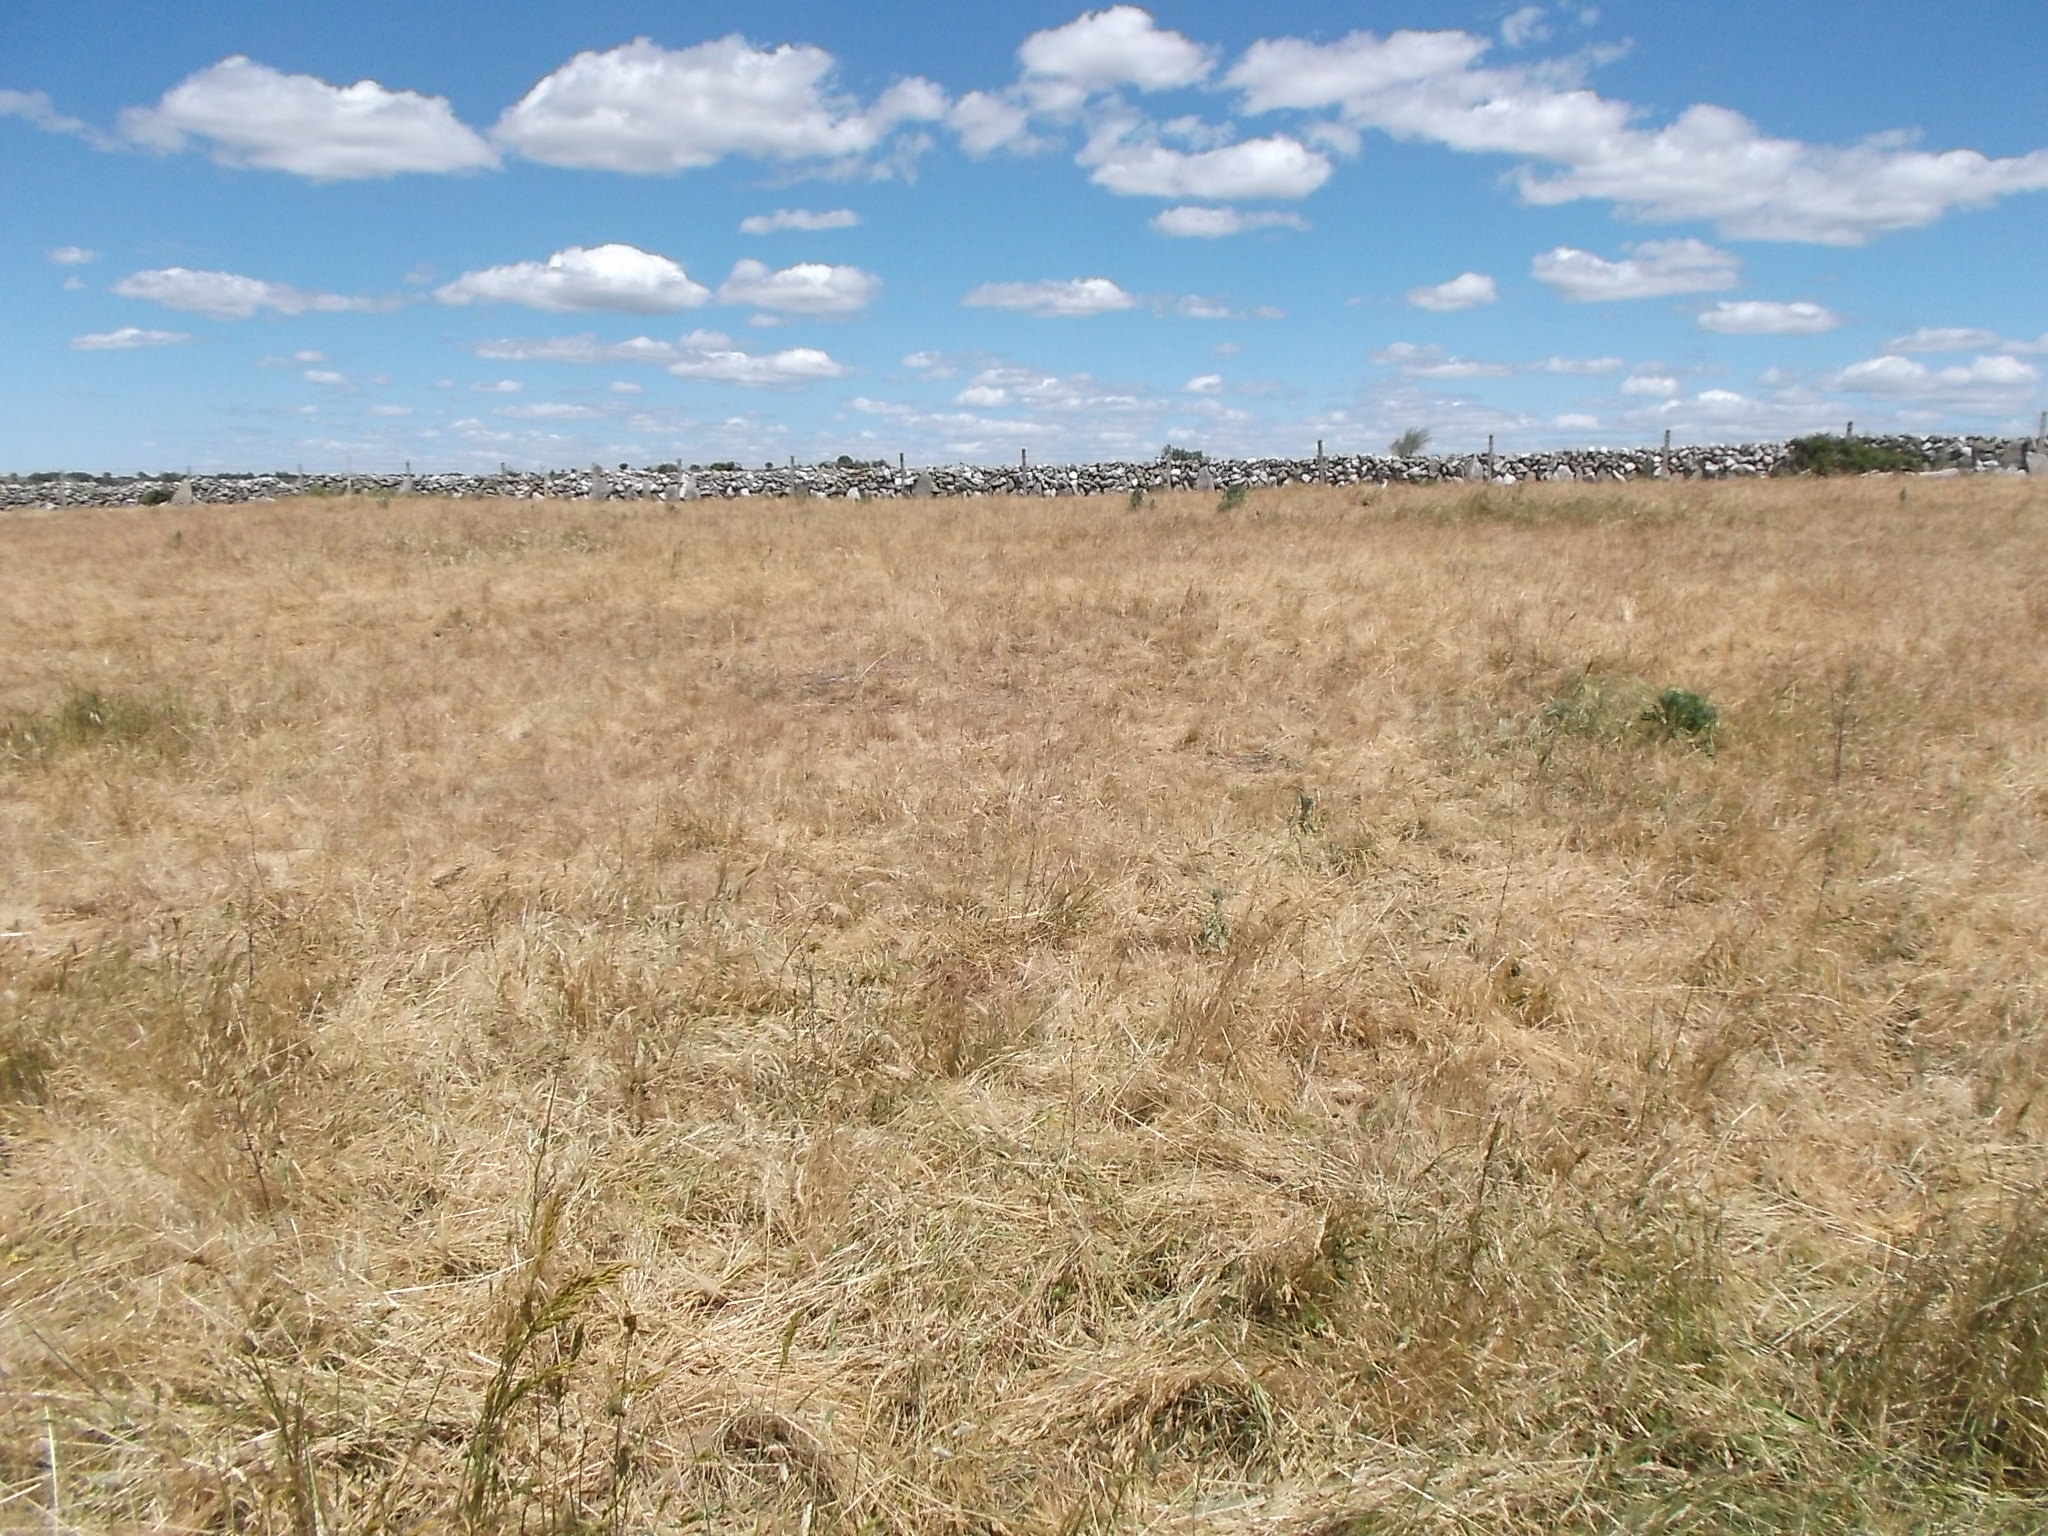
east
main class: Grassland
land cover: Grassland without tree/shrub cover
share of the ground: > 75 %
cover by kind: herbaceous plants 100 %
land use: Agriculture (excluding fallow land and kitchen gardens)
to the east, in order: Grassland without tree/shrub cover; Fences; Dry stone walls; Grass margins; Tracks; Grass margins; Dry stone walls; Grassland without tree/shrub cover; Dry stone walls; Grassland without tree/shrub cover; Dry stone walls; Grassland without tree/shrub cover; Dry stone walls; Grass margins; Paved roads, cycling and walking lanes; Grassland without tree/shrub cover; Dry stone walls; Grassland without tree/shrub cover
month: May
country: ES
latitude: 40.9619
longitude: -6.2604
